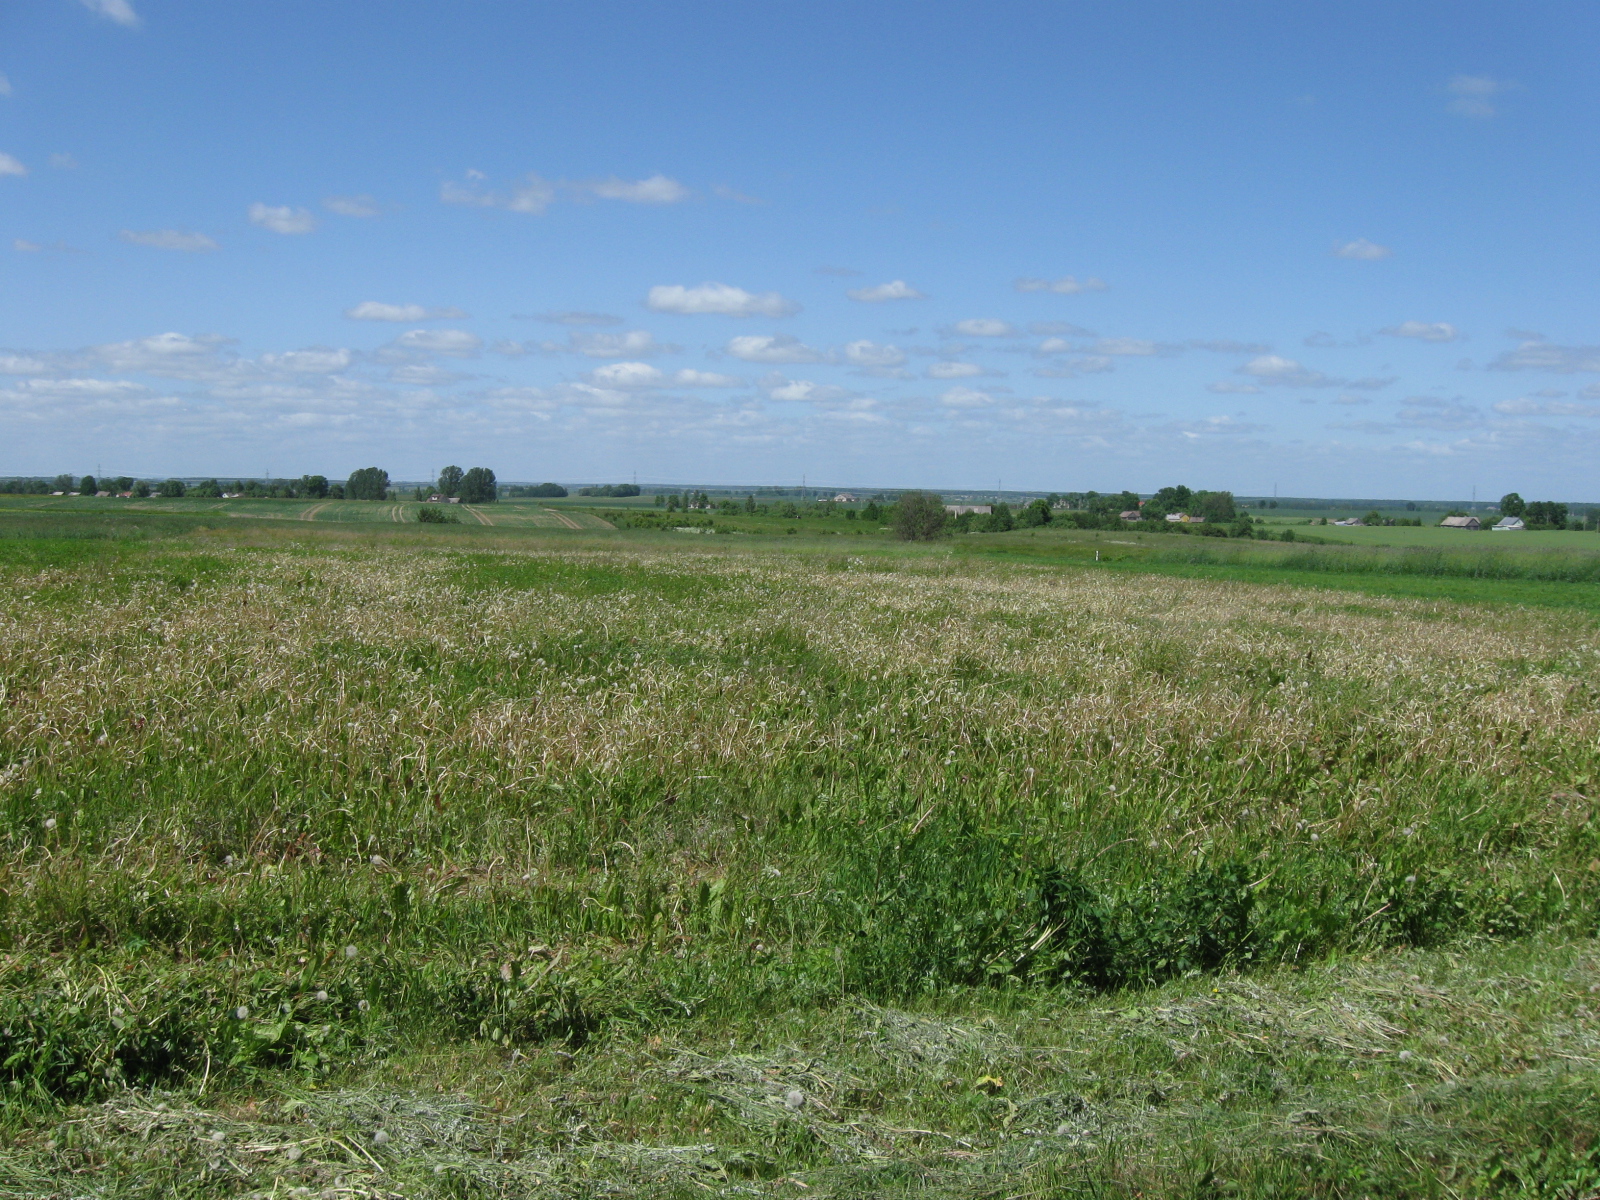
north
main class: Cropland
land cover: Apple fruit
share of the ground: 50 - 75 %
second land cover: Shrubland without tree cover
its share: 50 - 75 %
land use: Kitchen garden
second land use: Residential
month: June
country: LT
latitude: 54.3913
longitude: 23.8417
